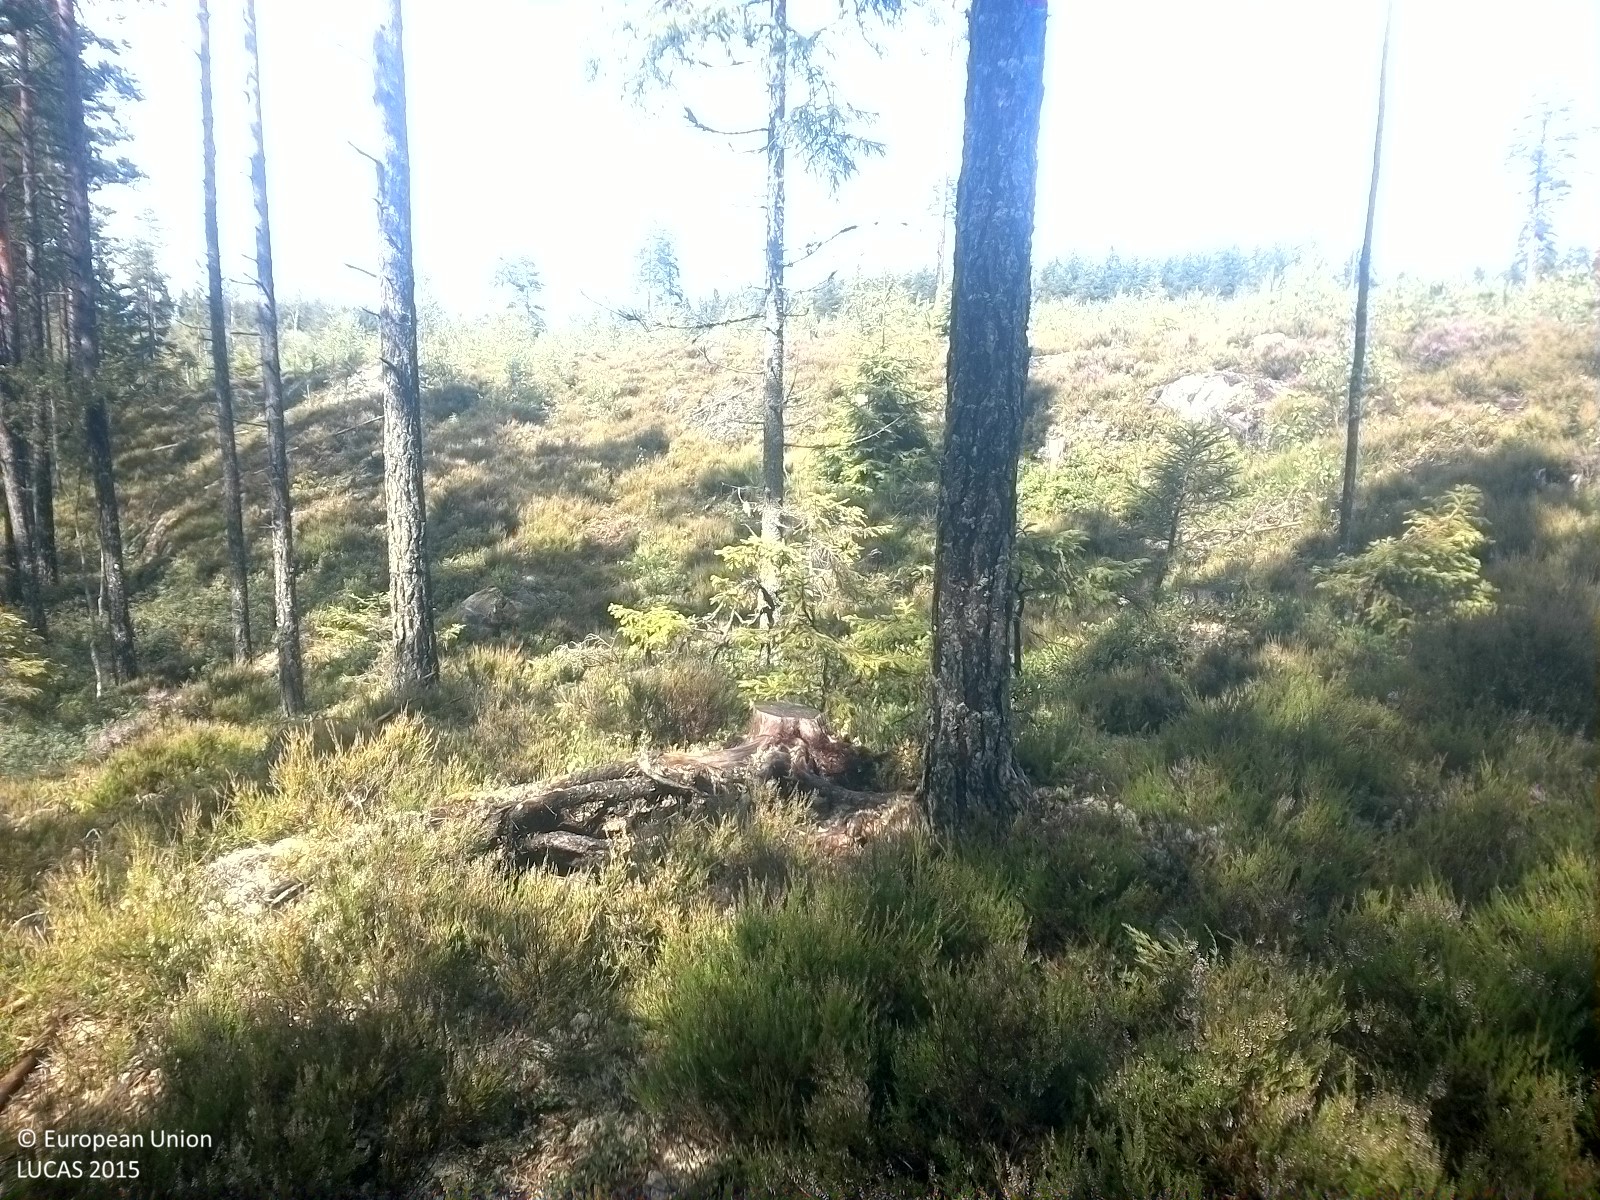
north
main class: Woodland
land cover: Pine dominated coniferous woodland
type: boreal forest
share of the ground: 25 - 50 %
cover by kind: coniferous forest trees 30 %, shrubs 30 %, herbaceous plants 20 %, lichens and mosses 20 %
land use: Forestry
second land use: Amenities, museums, leisure
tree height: > 5 m
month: July
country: SE
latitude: 58.8809
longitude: 15.0755
